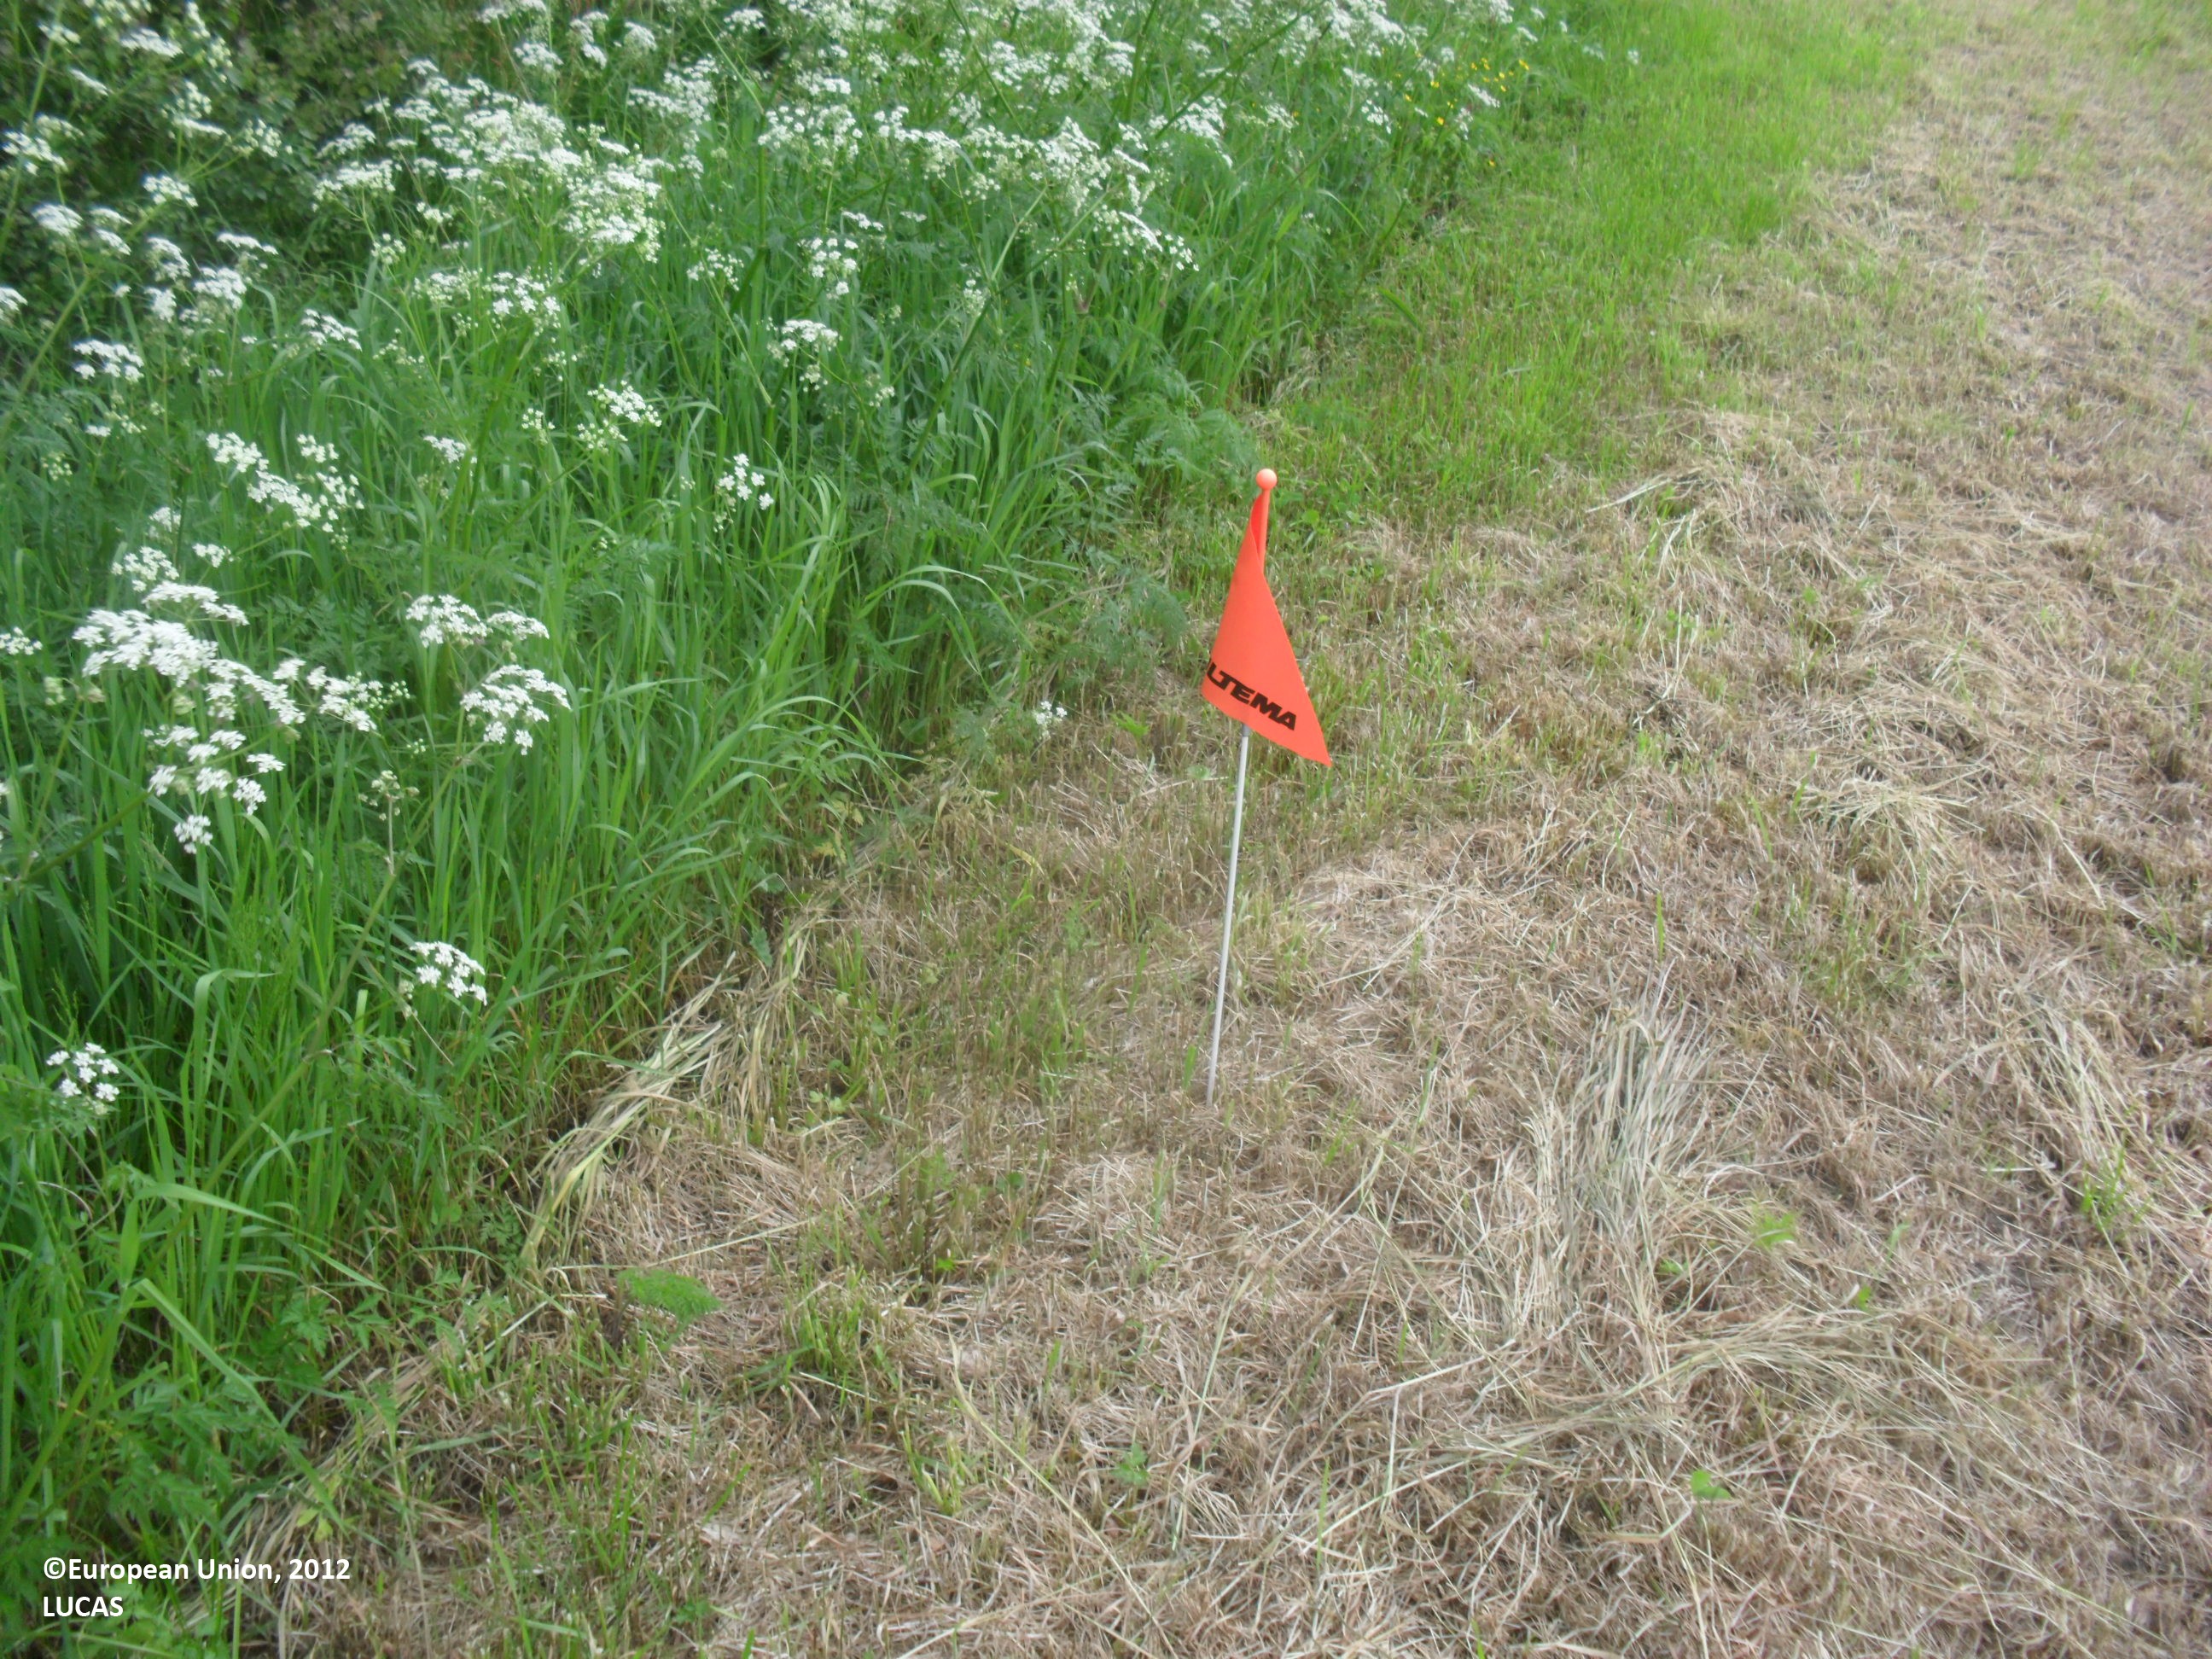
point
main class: Grassland
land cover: Grassland without tree/shrub cover
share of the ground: > 75 %
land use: Agriculture (excluding fallow land and kitchen gardens)
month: June
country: FI
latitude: 63.4831
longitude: 23.1257
